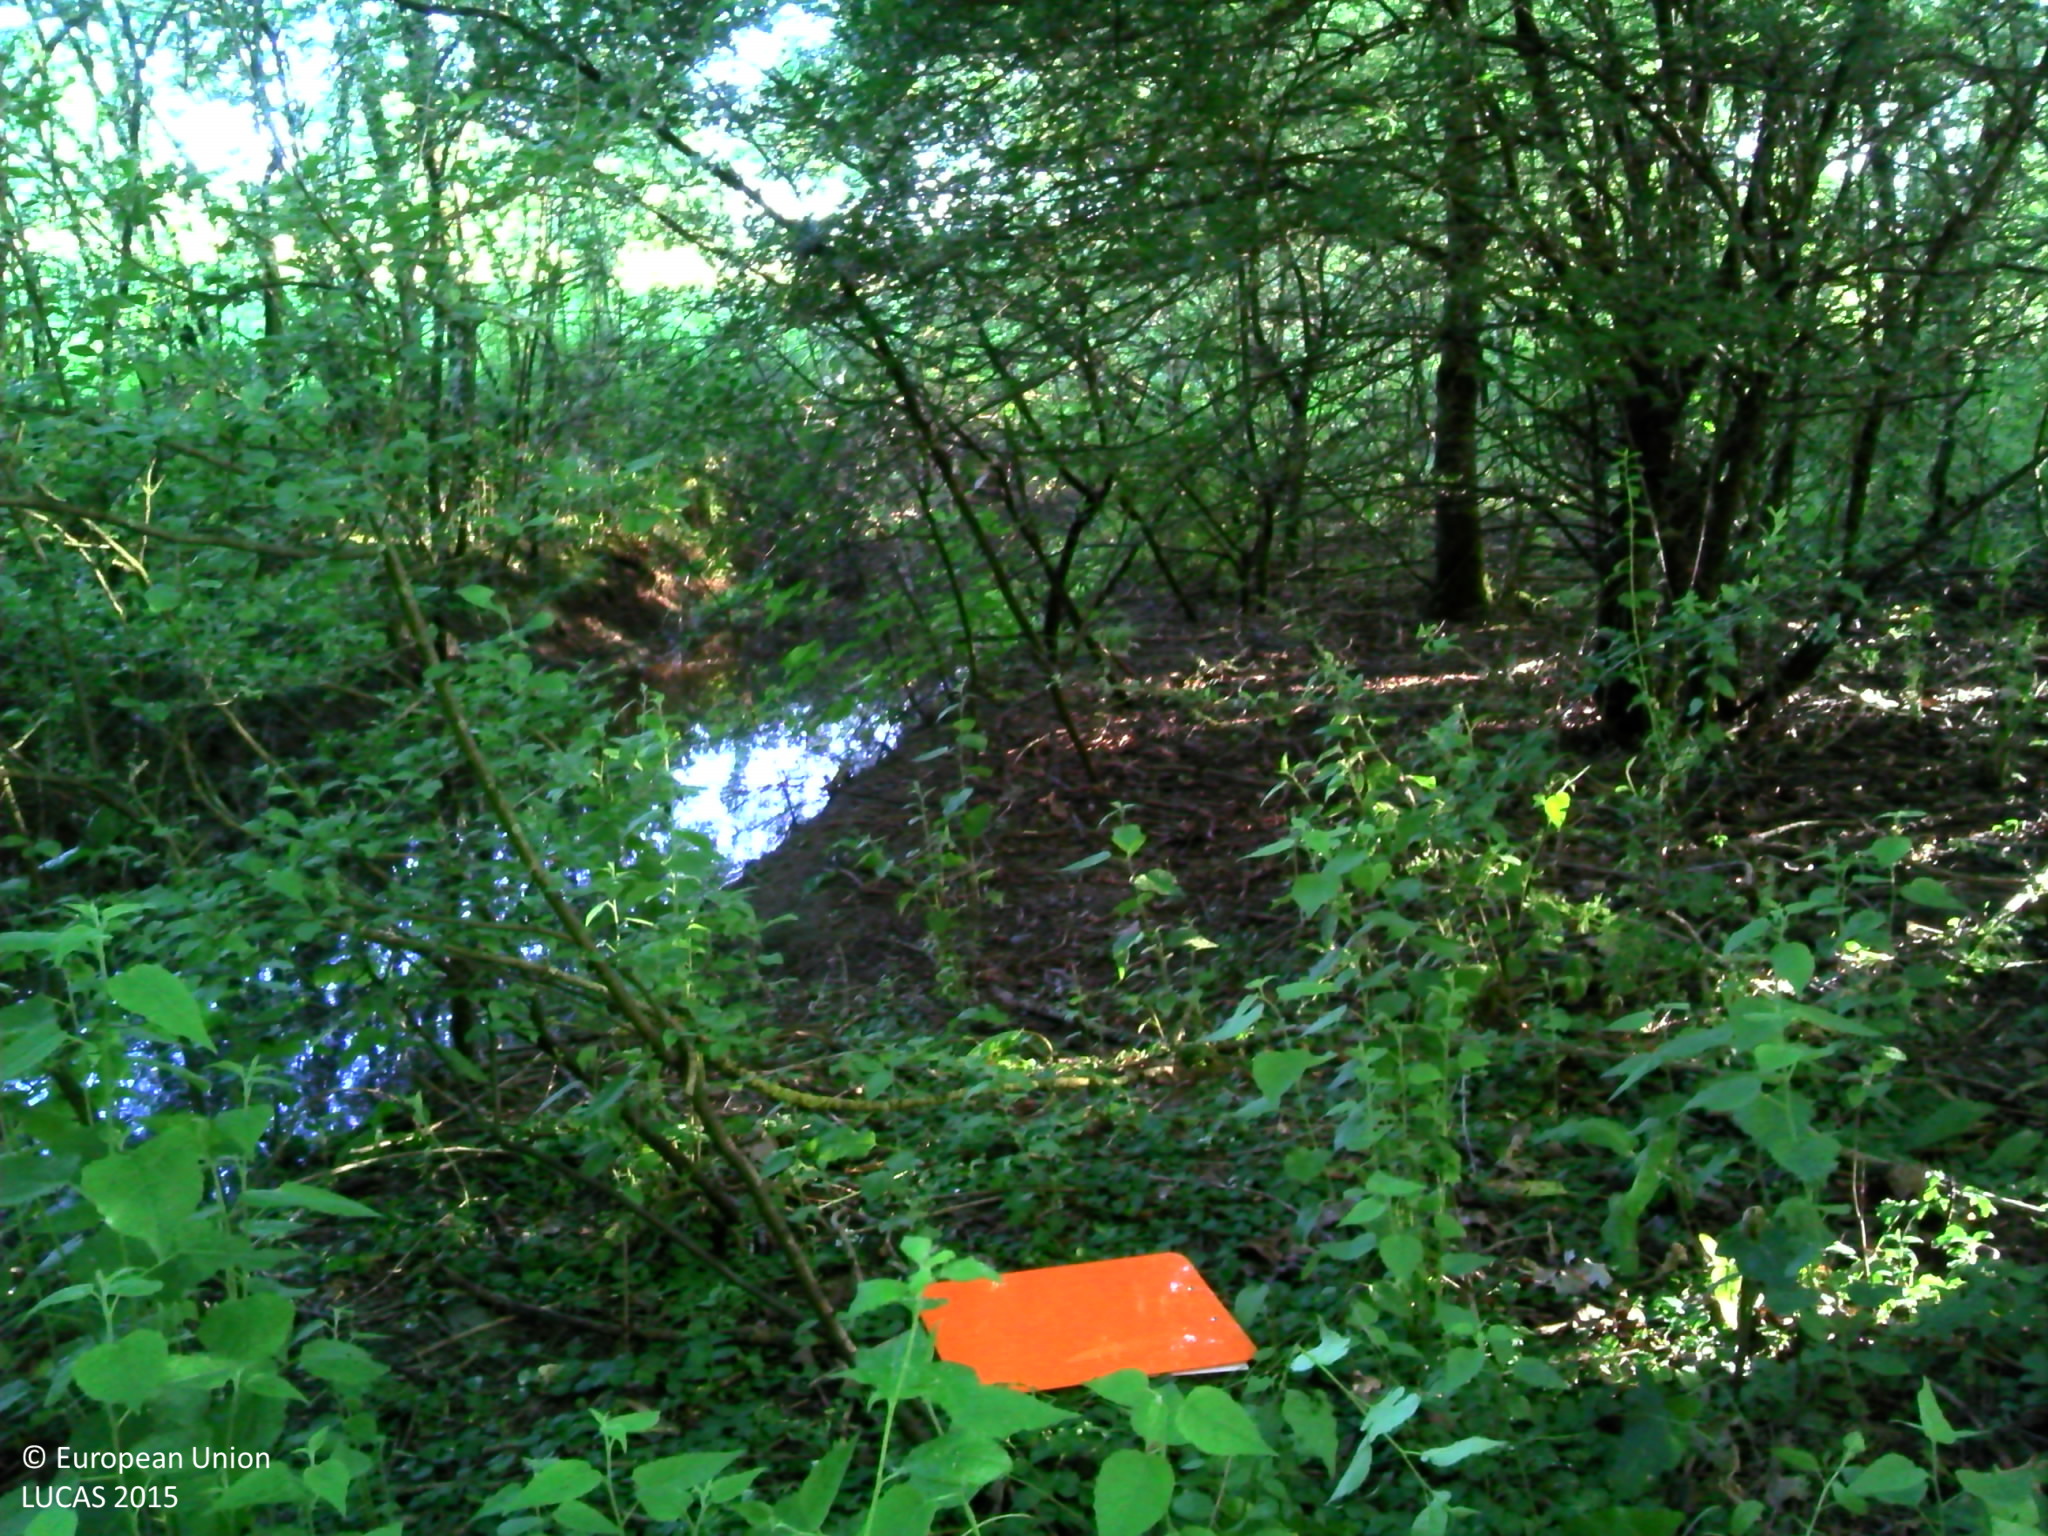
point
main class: Woodland
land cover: Broadleaved woodland
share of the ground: > 75 %
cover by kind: broadleaved forest trees 95 %, herbaceous plants 5 %
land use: Semi-natural and natural areas not in use
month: June
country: FR
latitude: 47.2234
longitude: -1.4644
